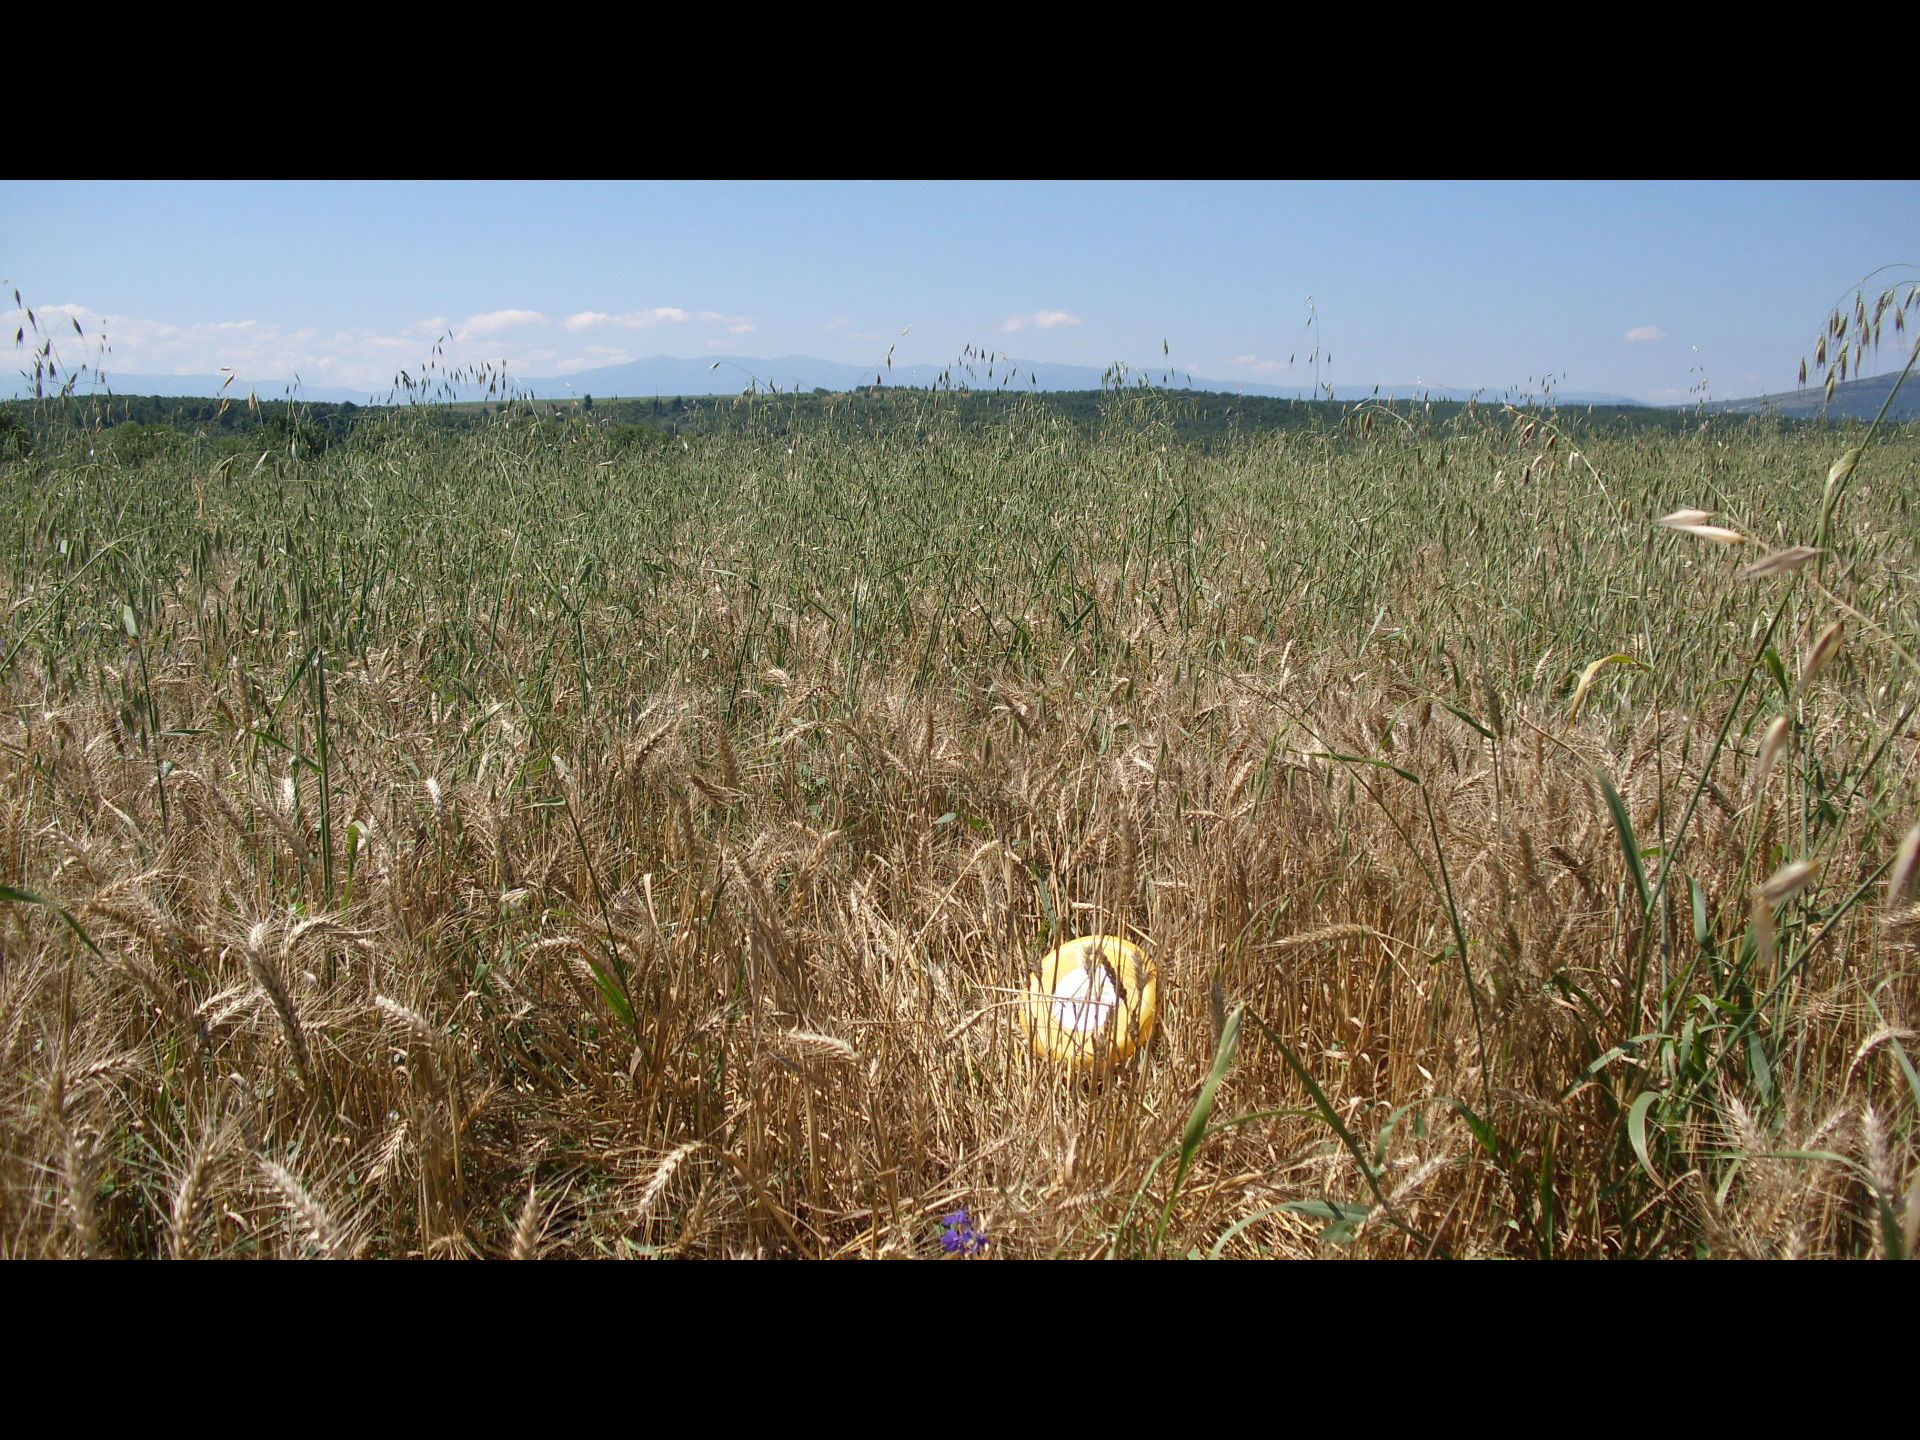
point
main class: Cropland
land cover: Common wheat
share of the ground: > 75 %
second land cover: Oats
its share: 10 - 25 %
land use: Agriculture (excluding fallow land and kitchen gardens)
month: June
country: BG
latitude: 43.4629
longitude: 23.2282
